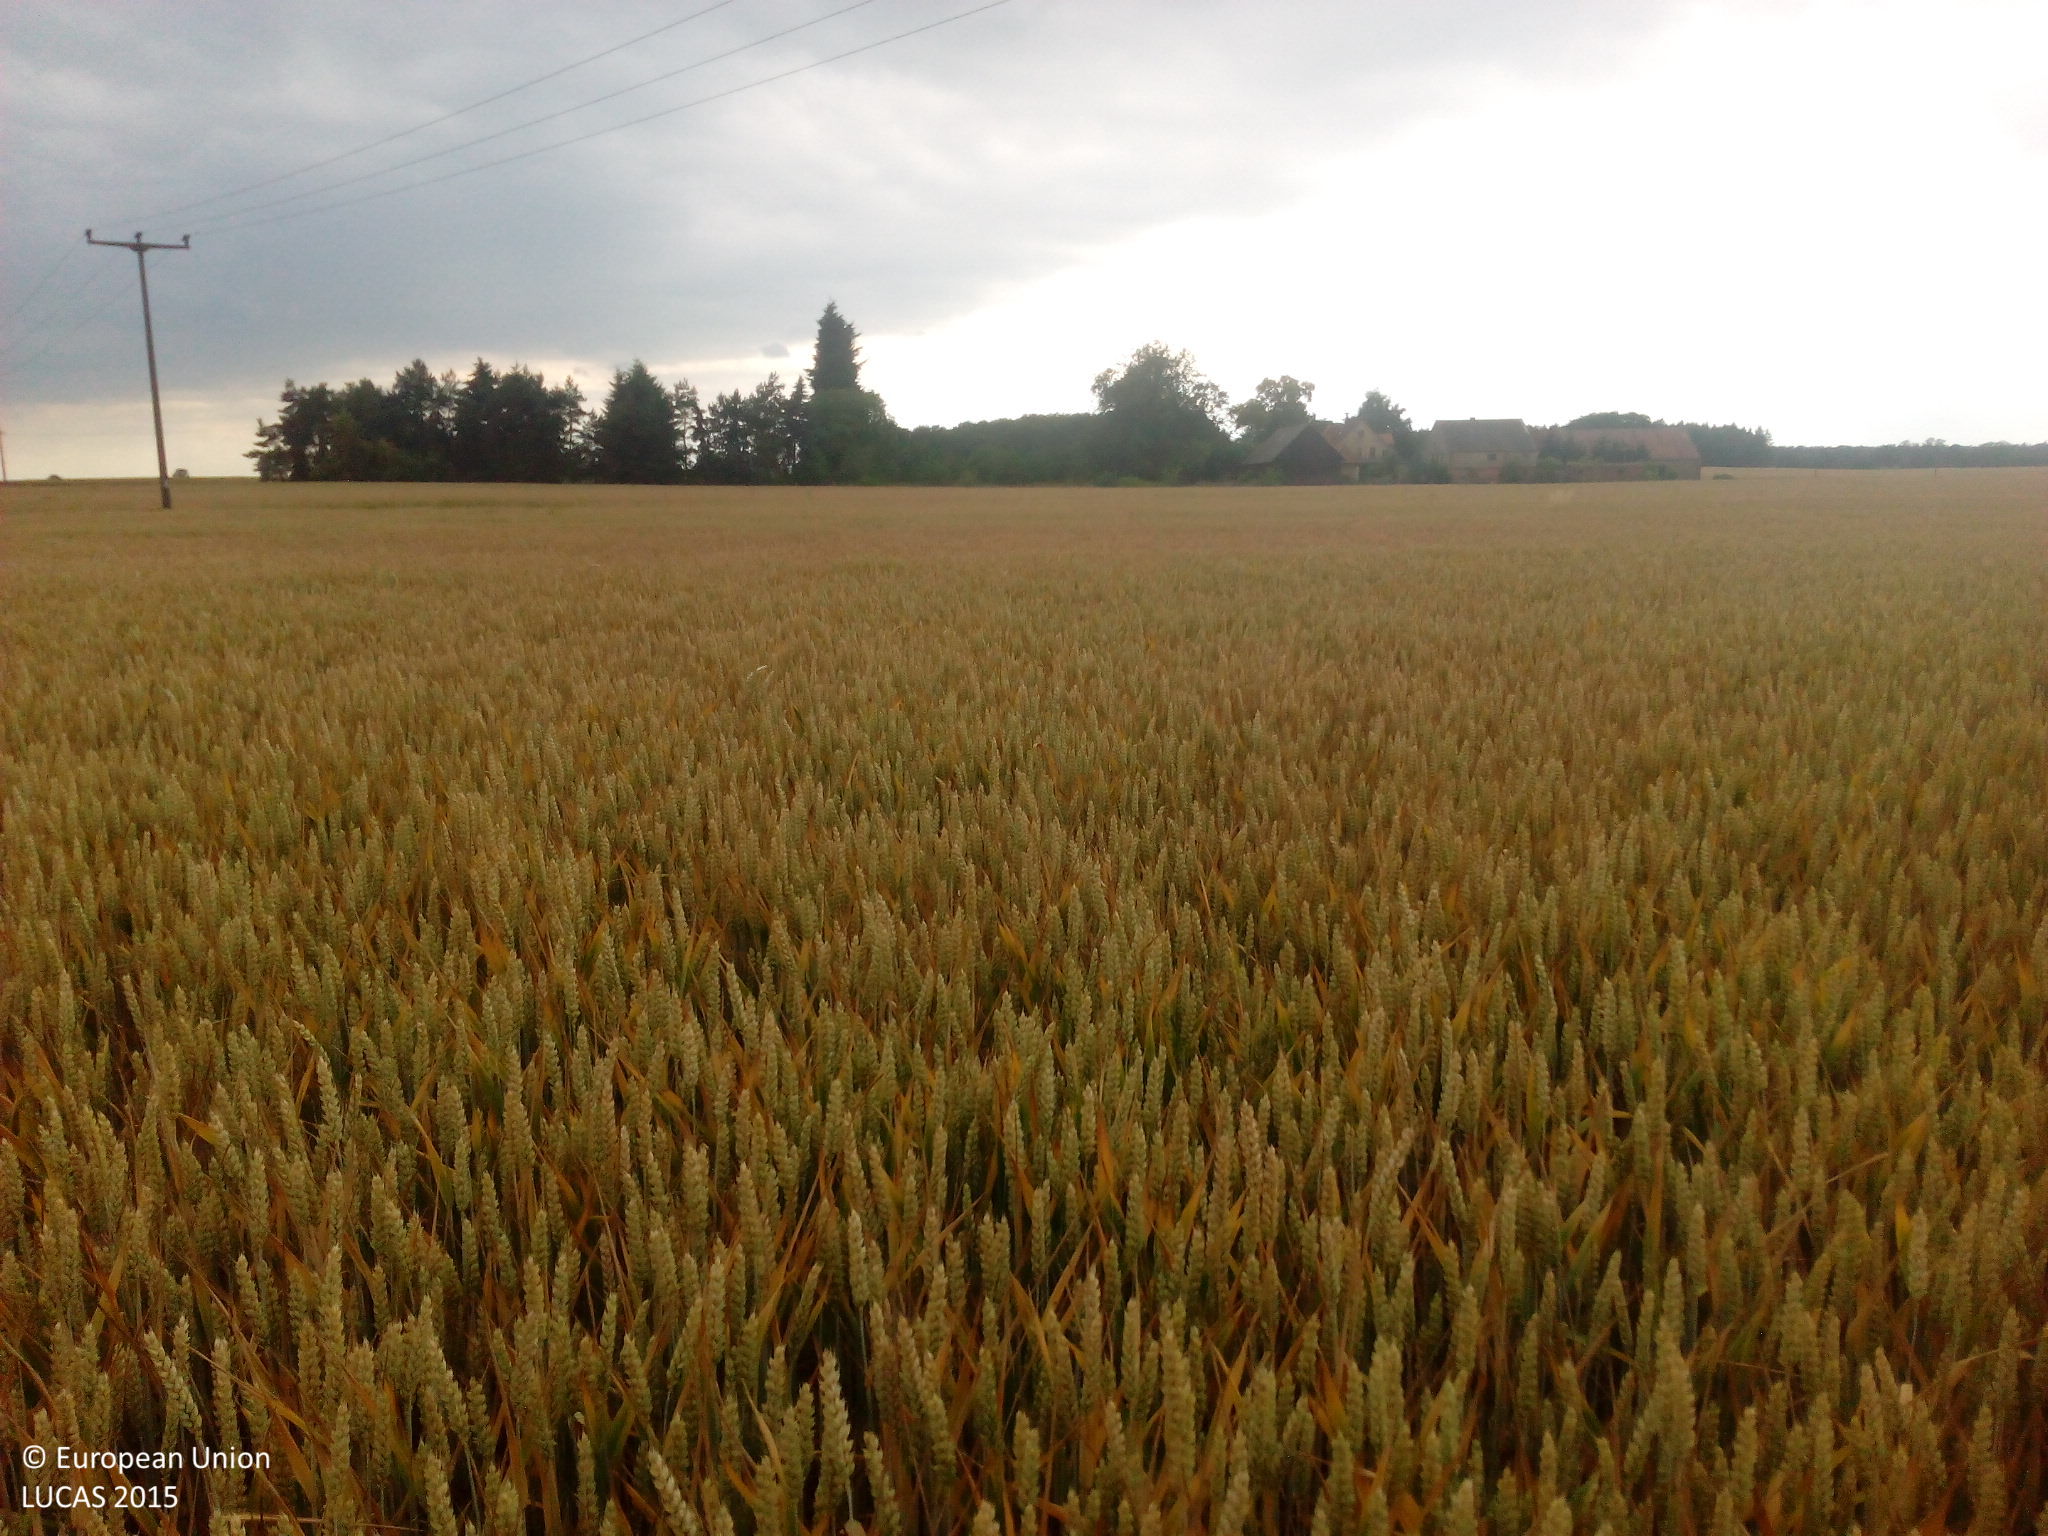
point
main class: Cropland
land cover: Common wheat
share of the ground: > 75 %
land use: Agriculture (excluding fallow land and kitchen gardens)
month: July
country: DE
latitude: 52.9120
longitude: 12.3341
